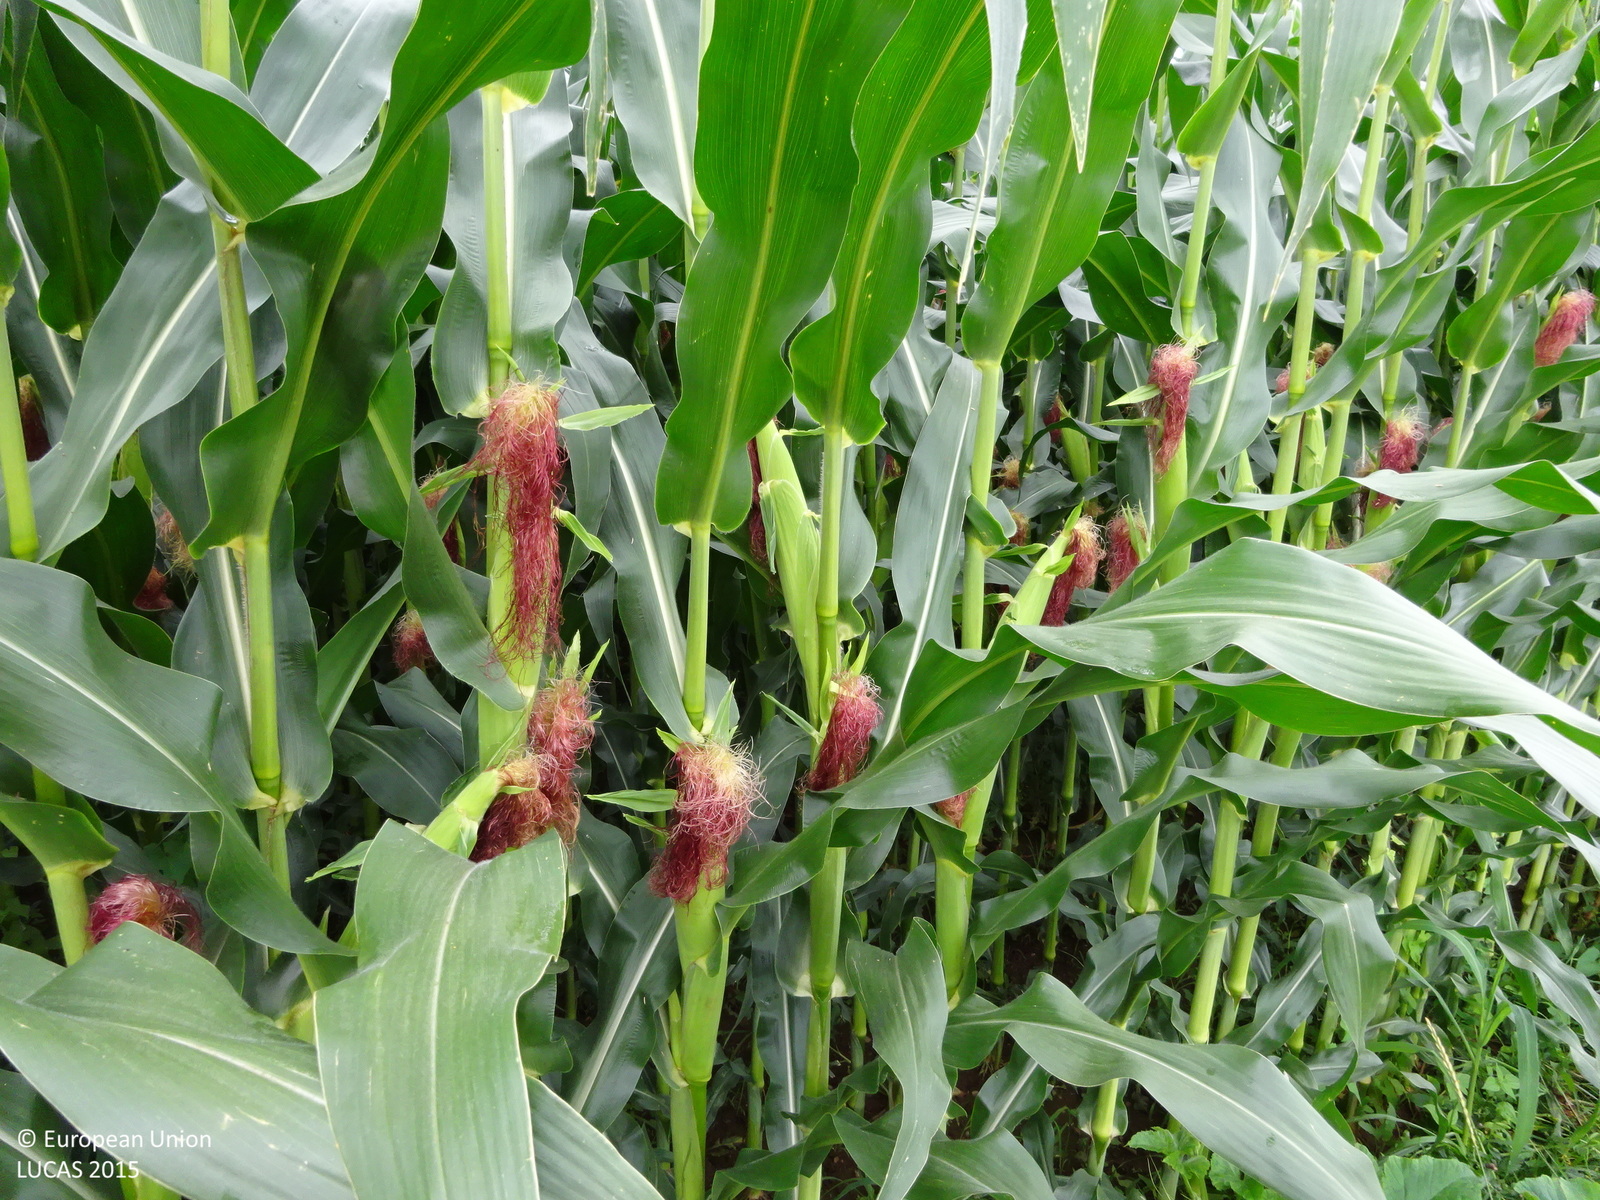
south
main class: Cropland
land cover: Other fibre and oleaginous crops
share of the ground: > 75 %
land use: Agriculture (excluding fallow land and kitchen gardens)
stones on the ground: < 10 %
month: July
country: AT
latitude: 46.9508
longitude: 15.4787
